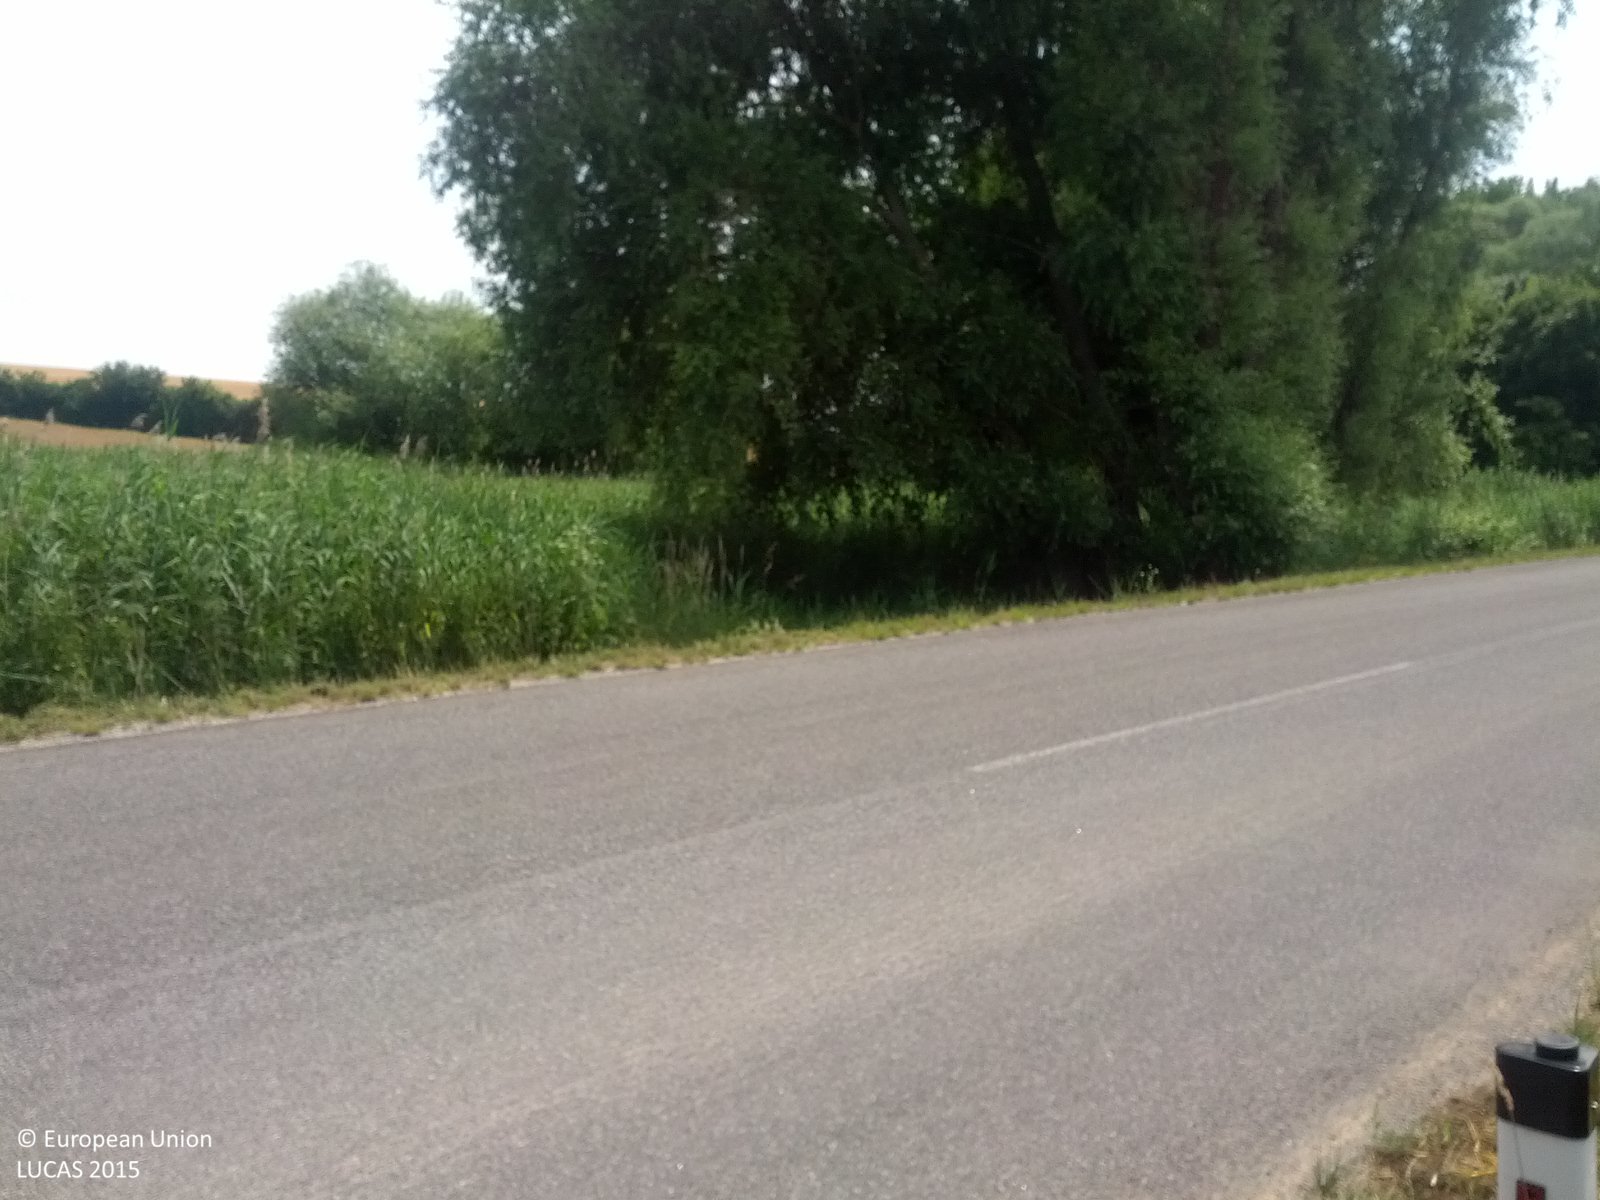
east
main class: Cropland
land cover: Common wheat
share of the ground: > 75 %
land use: Agriculture (excluding fallow land and kitchen gardens)
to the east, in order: Common wheat; Grass margins; Paved roads, cycling and walking lanes; Grass margins; Lines of trees; Inland marshes; Rivers and streams; Lines of trees; Inland marshes; Grass margins; Tracks; Grass margins; Clovers; Rape and turnip rape; Abandoned hedges; Grass margins; Barley
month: June
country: AT
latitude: 48.7020
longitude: 16.7605
